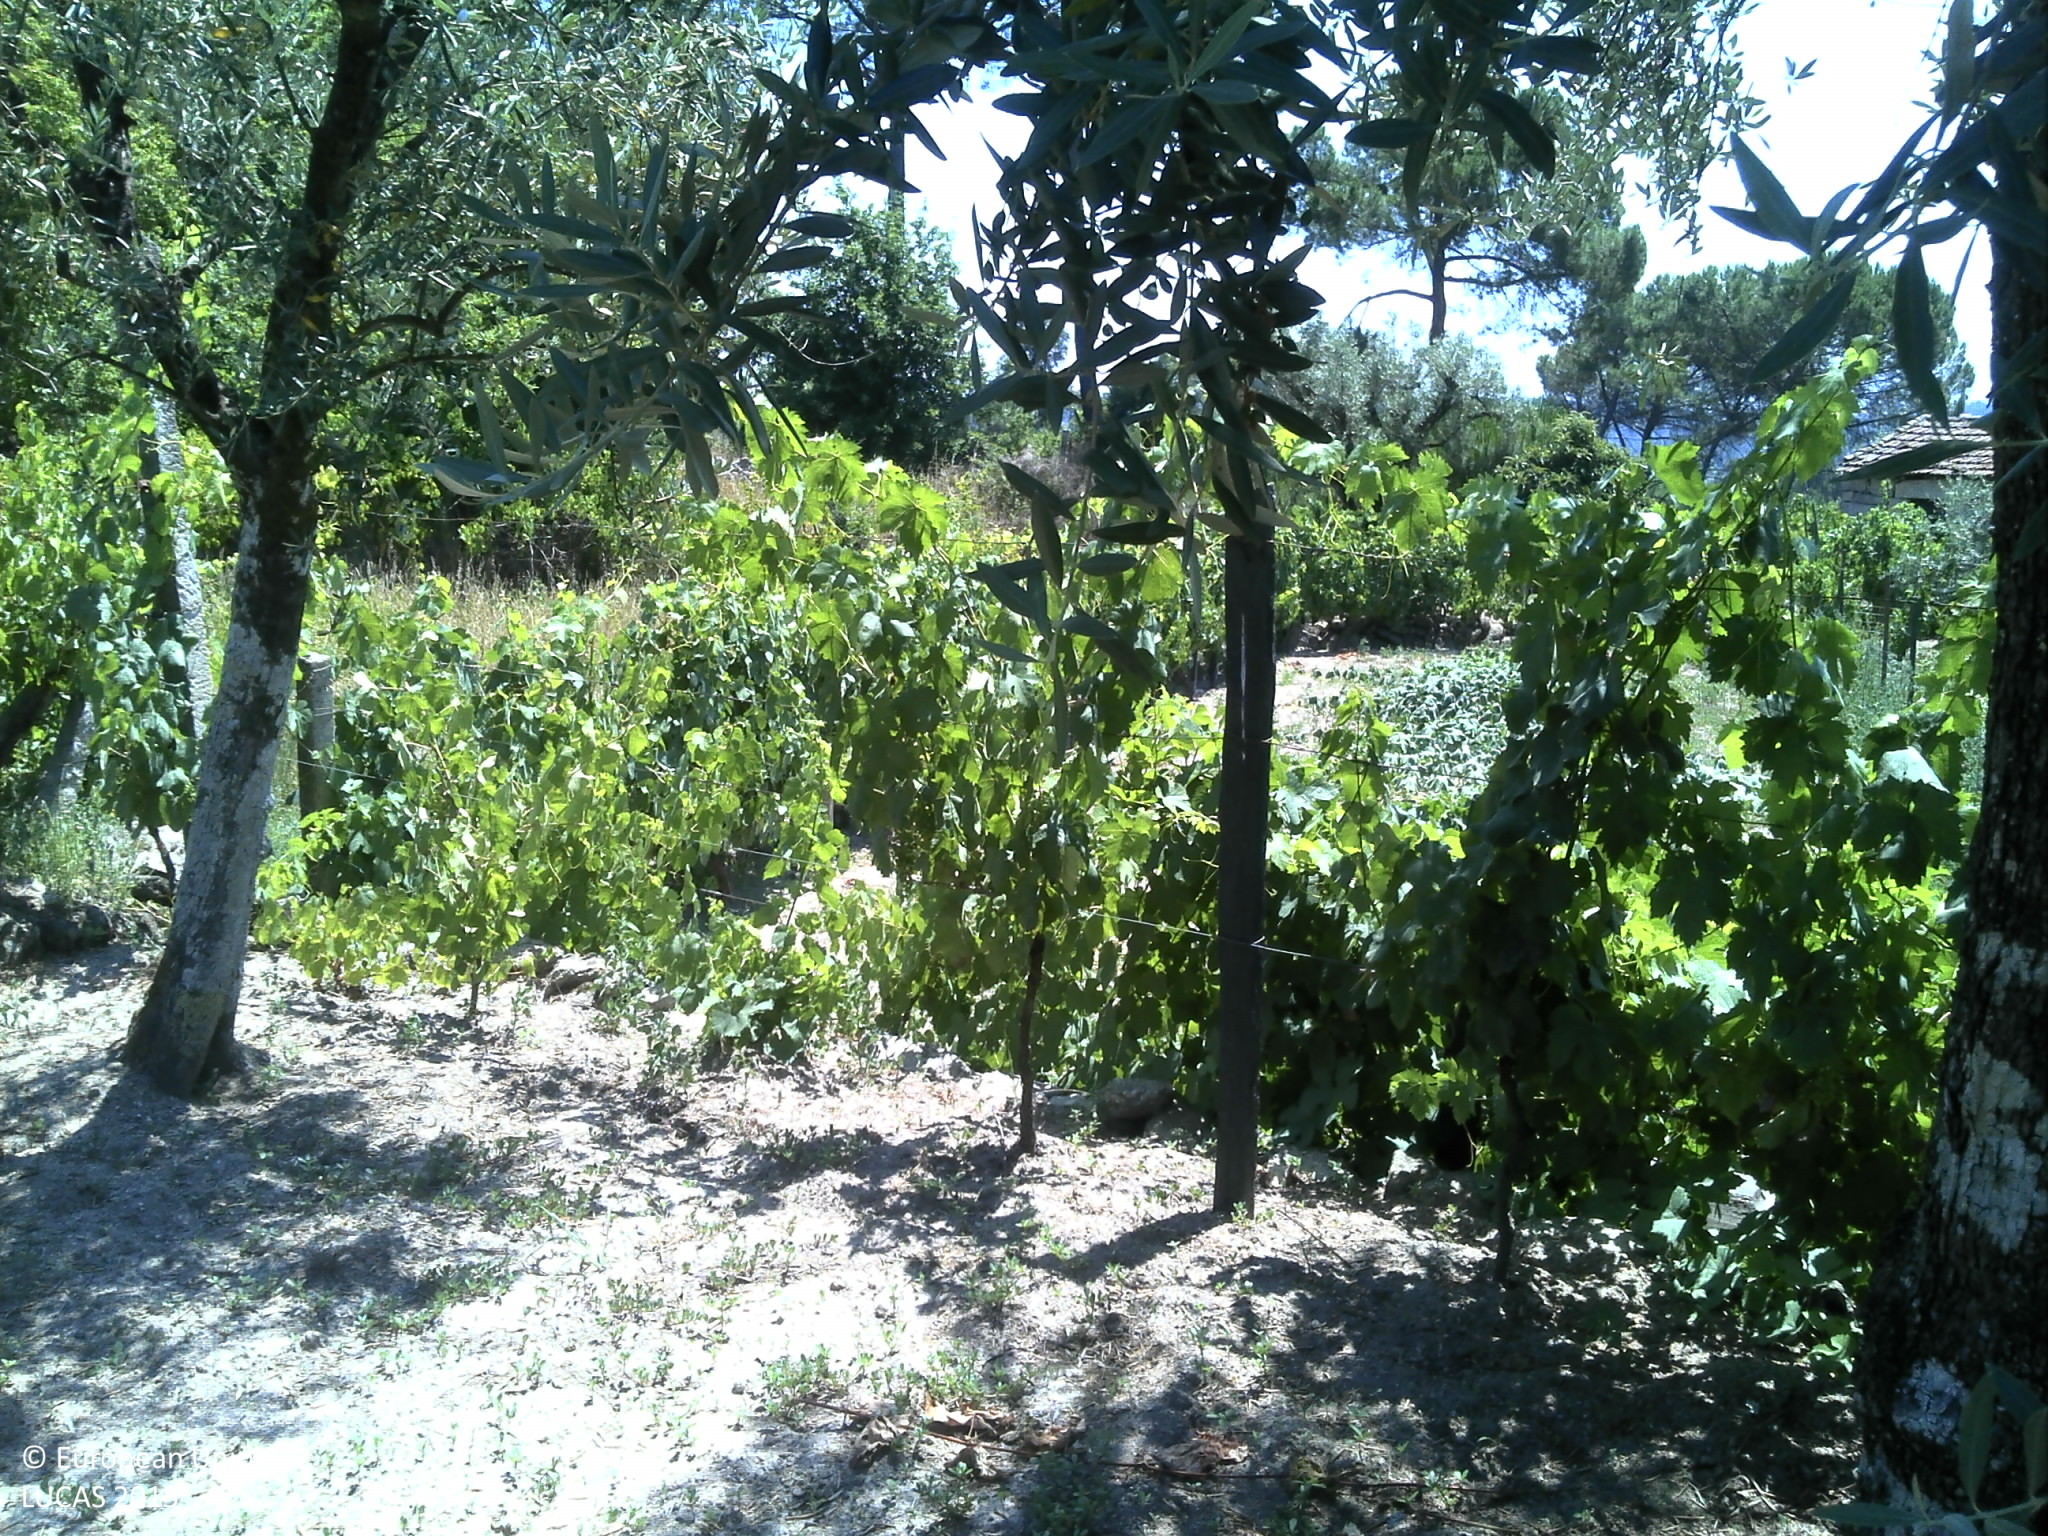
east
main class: Grassland
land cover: Grassland with sparse tree/shrub cover
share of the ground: 10 - 25 %
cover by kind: unconsolidated bare surface 70 %, herbaceous plants 25 %, broadleaved forest trees 5 %
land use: Agriculture (excluding fallow land and kitchen gardens)
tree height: > 5 m
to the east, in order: Grassland with sparse tree/shrub cover; Abandoned hedges; Vineyards; Dry stone walls; Vineyards; Other root crops; Vineyards; Spontaneously vegetated surfaces; Shrubland with sparse tree cover; Pine dominated coniferous woodland; Tracks; Pine dominated coniferous woodland; Tracks; Permanent crops (only in case pi); Tracks; Permanent crops (only in case pi); Tracks; Pine dominated coniferous woodland; Tracks; Pine dominated coniferous woodland
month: June
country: PT
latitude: 40.5516
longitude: -7.9671
